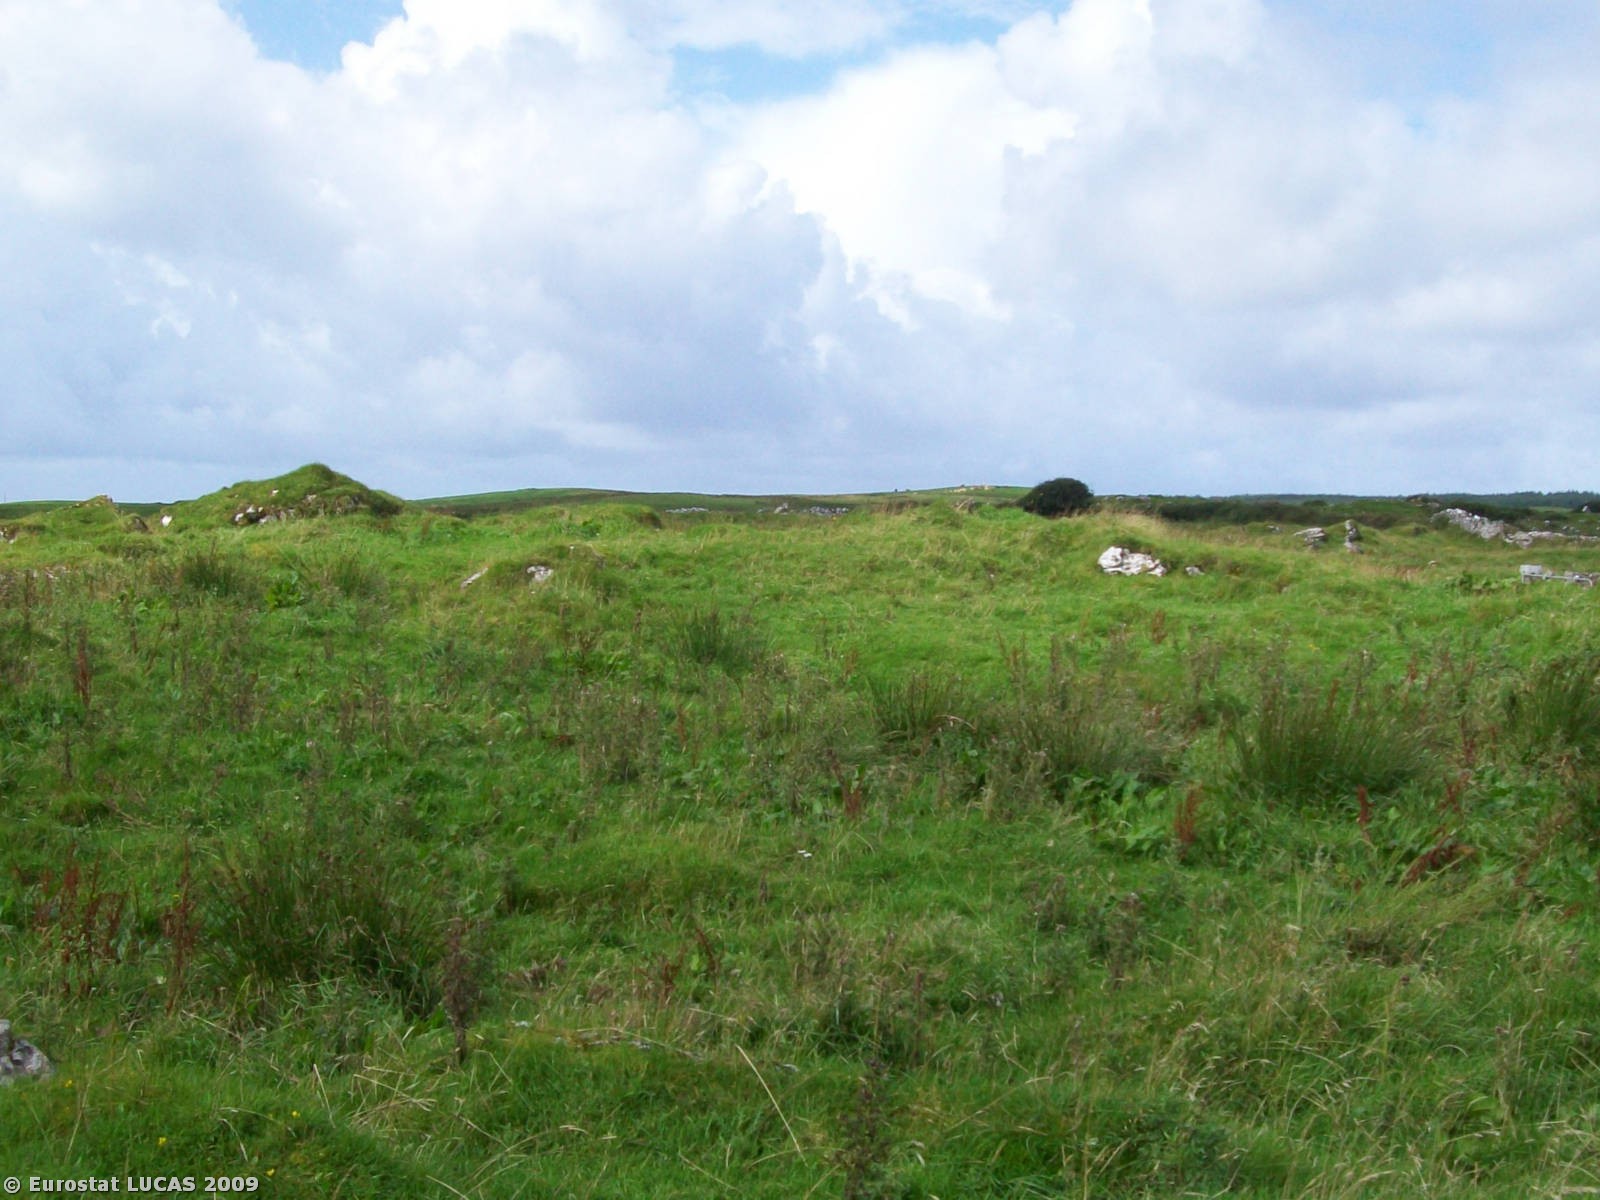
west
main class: Grassland
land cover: Grassland without tree/shrub cover
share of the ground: > 75 %
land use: Agriculture (excluding fallow land and kitchen gardens)
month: August
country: IE
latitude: 53.0361
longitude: -9.2674
